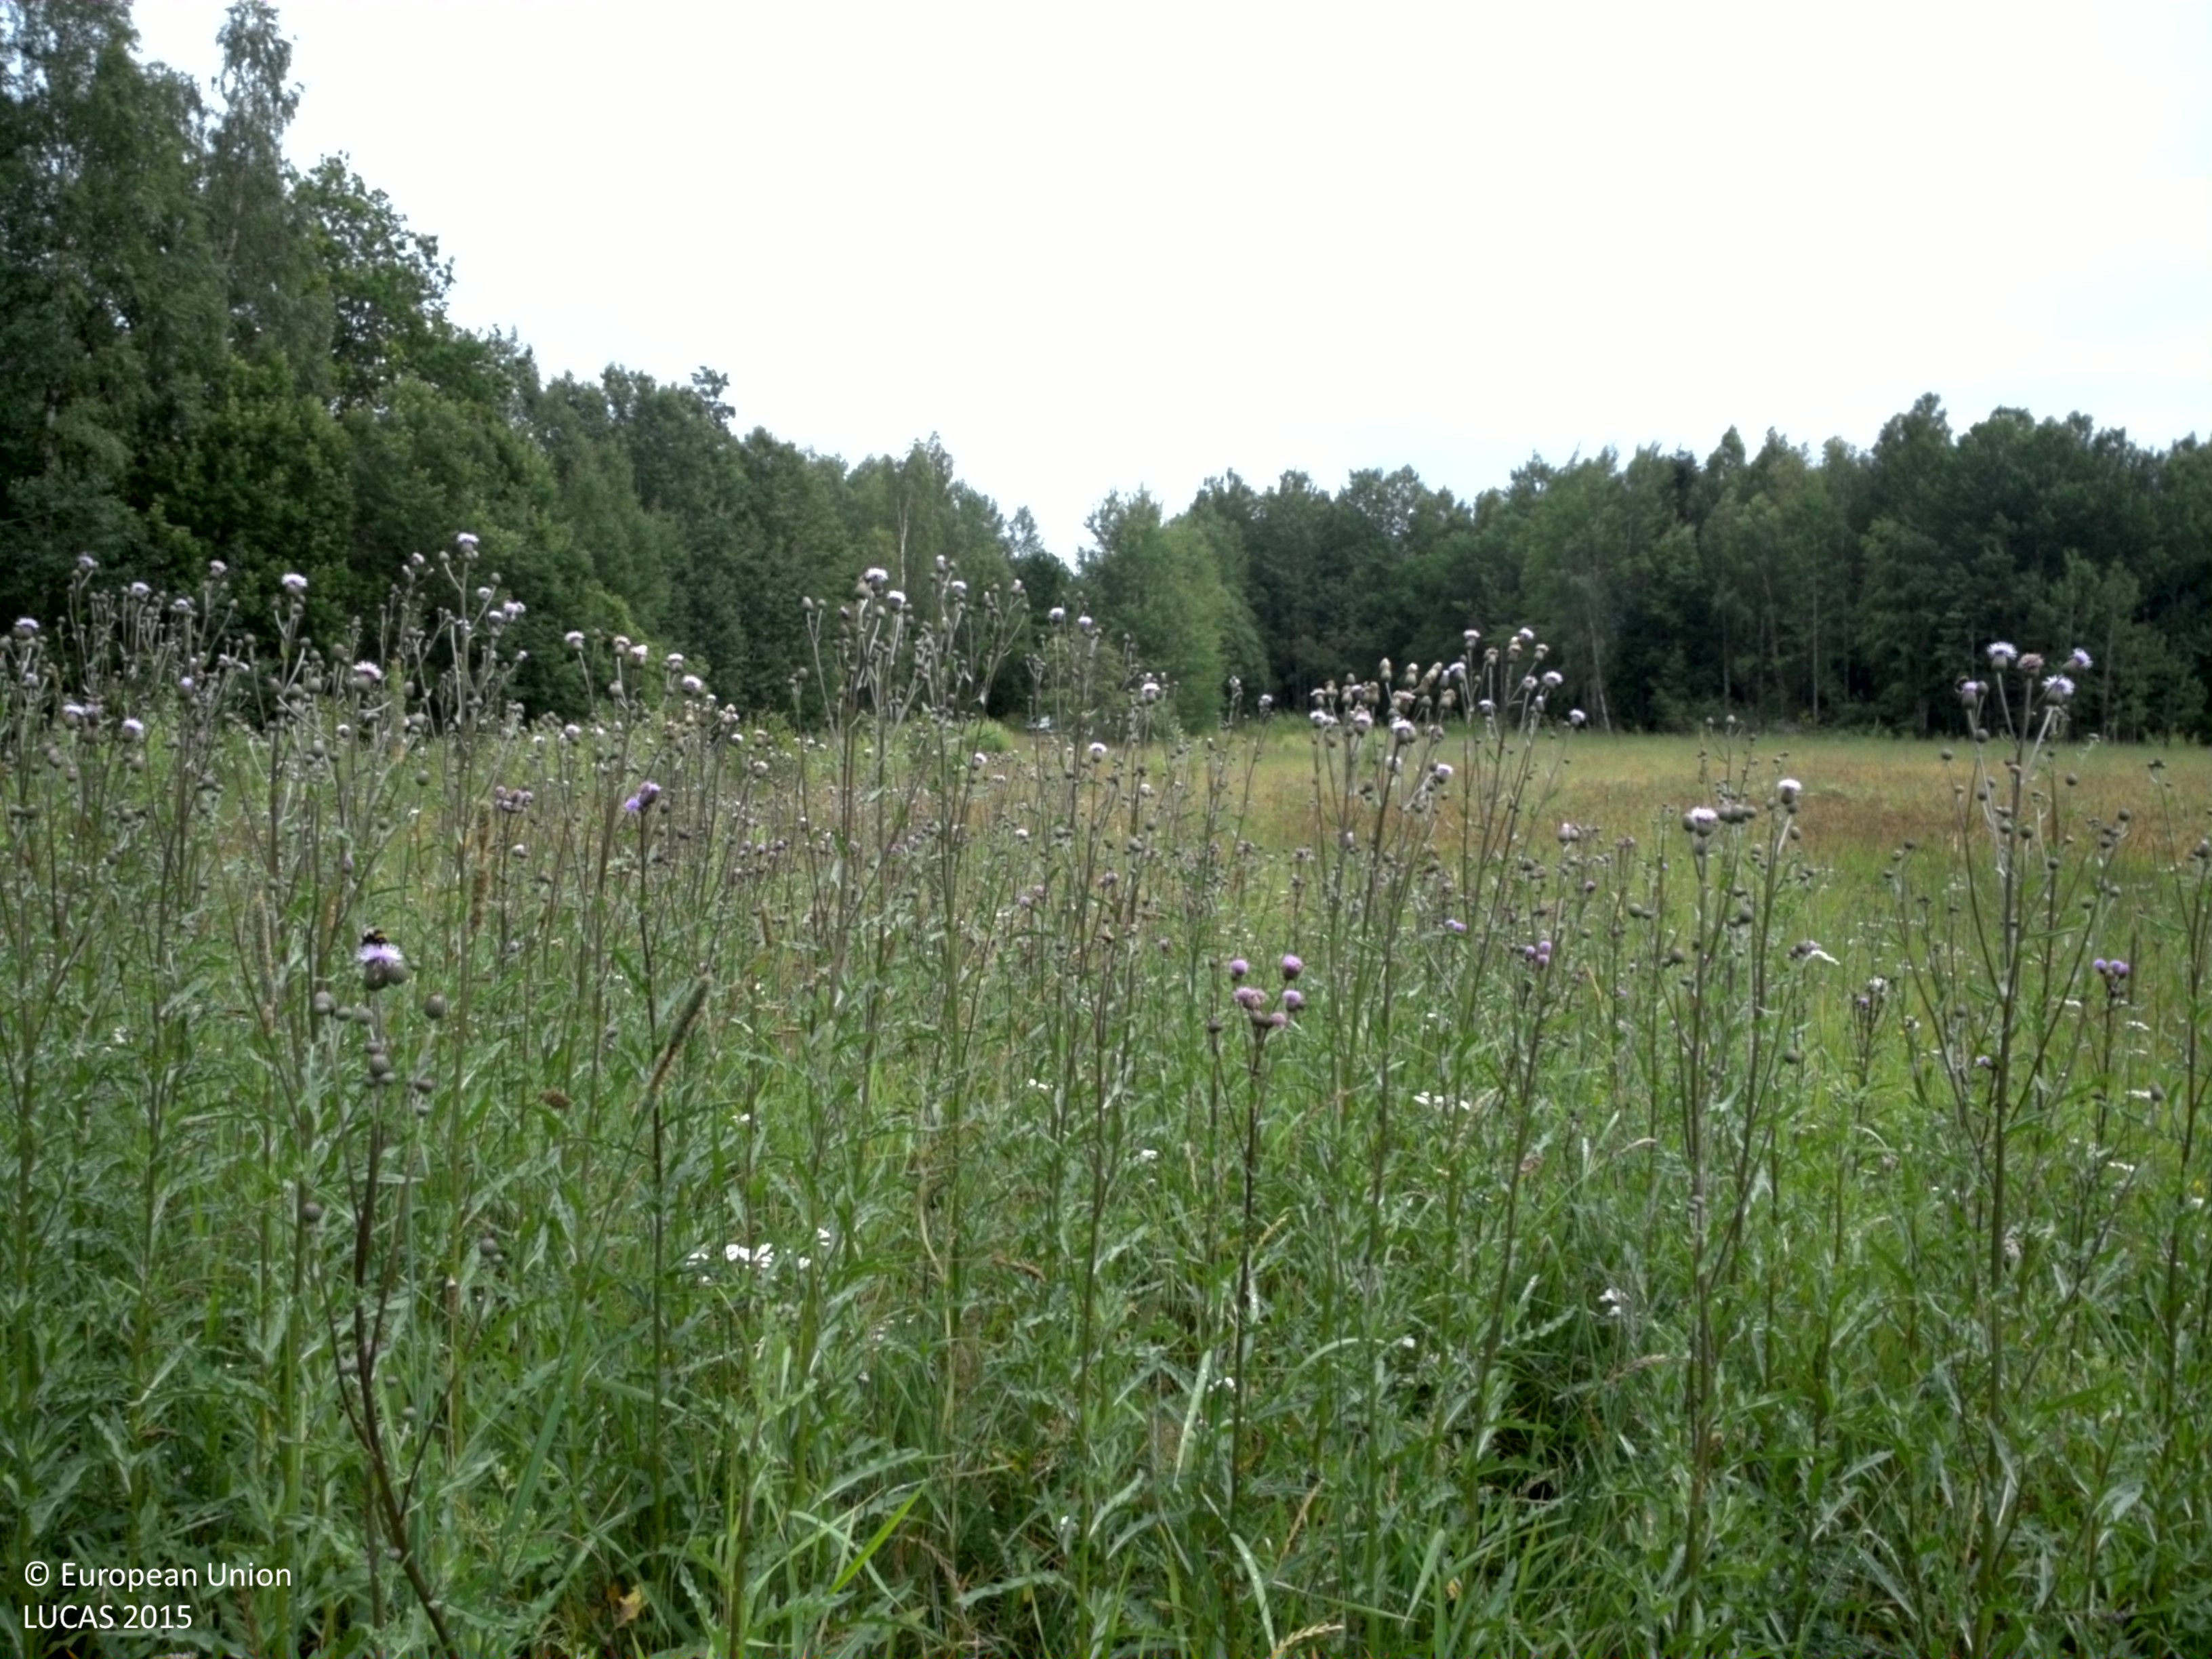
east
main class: Grassland
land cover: Grassland without tree/shrub cover
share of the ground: > 75 %
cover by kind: herbaceous plants 100 %
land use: Semi-natural and natural areas not in use
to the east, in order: Grassland without tree/shrub cover; Groves; Ditches and canals; Grass margins; Paved roads, cycling and walking lanes; Ditches and canals; Pine dominated mixed woodland; Broadleaved woodland; Pine dominated mixed woodland
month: July
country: SE
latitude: 59.5966
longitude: 18.5206
